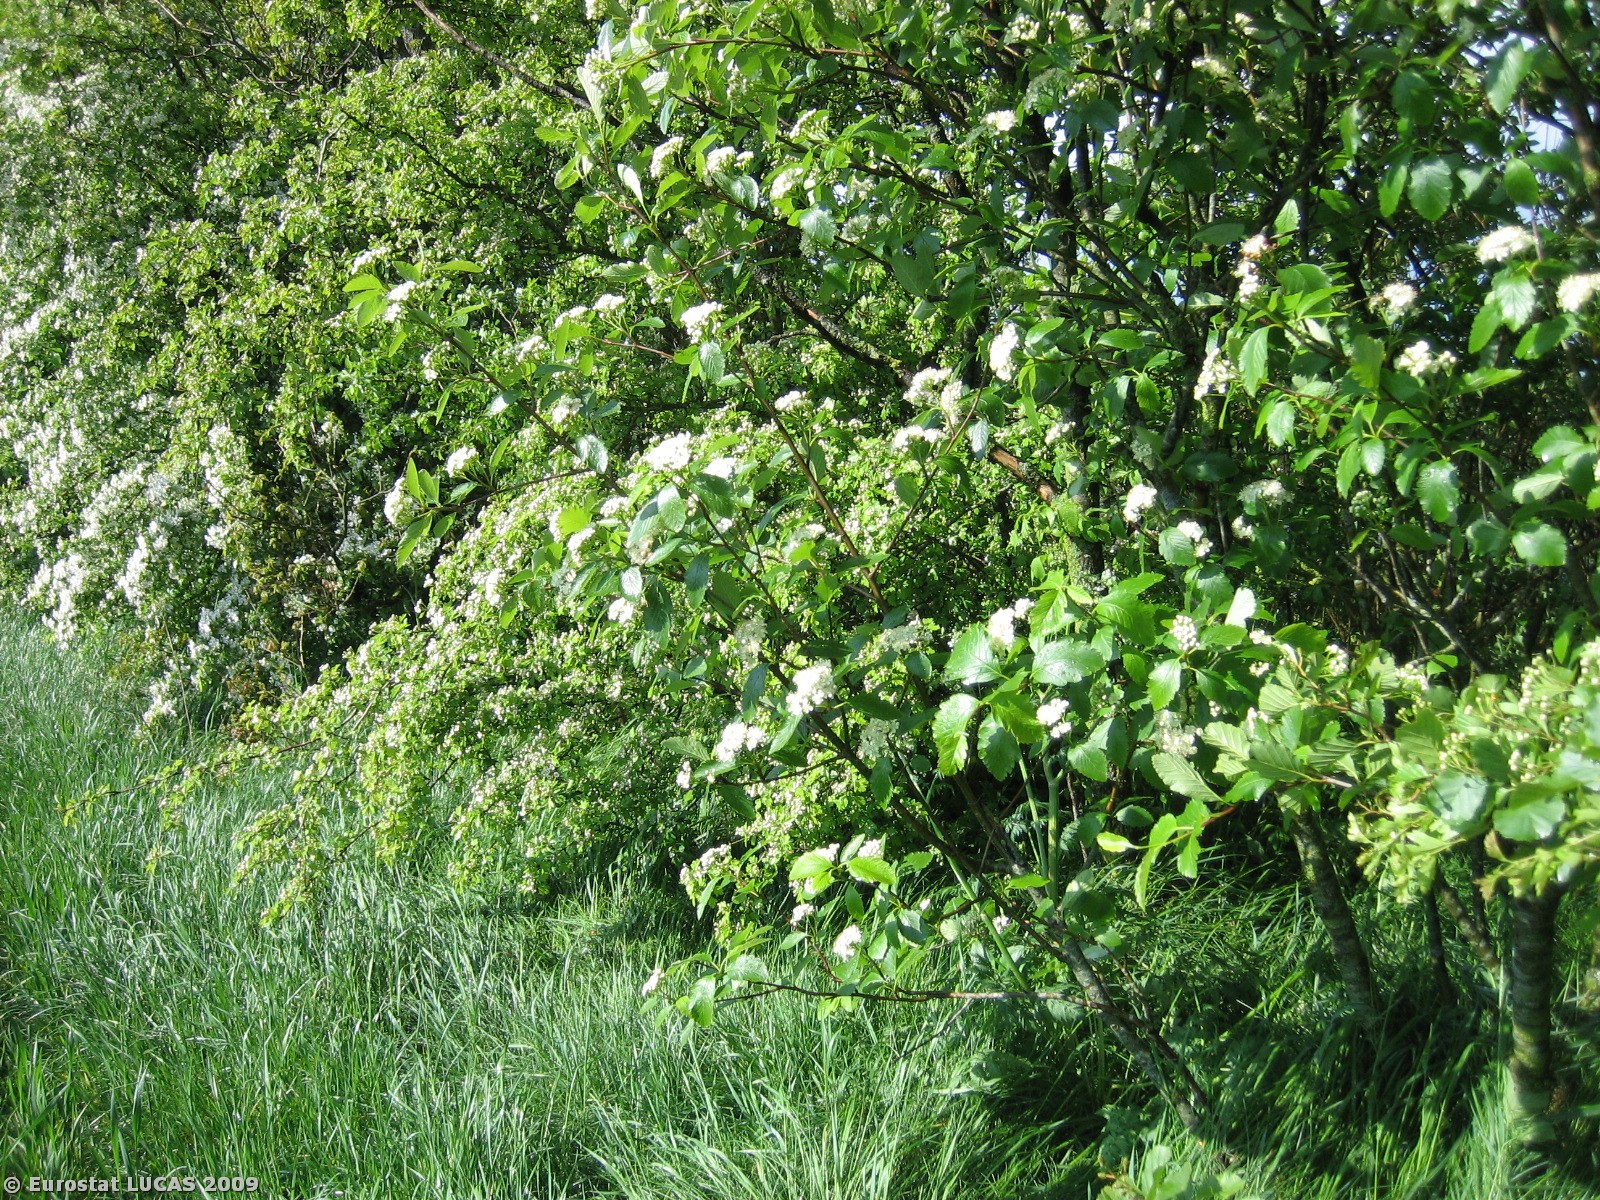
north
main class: Woodland
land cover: Broadleaved woodland
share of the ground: > 75 %
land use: Forestry
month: May
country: DK
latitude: 56.1638
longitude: 8.7615
